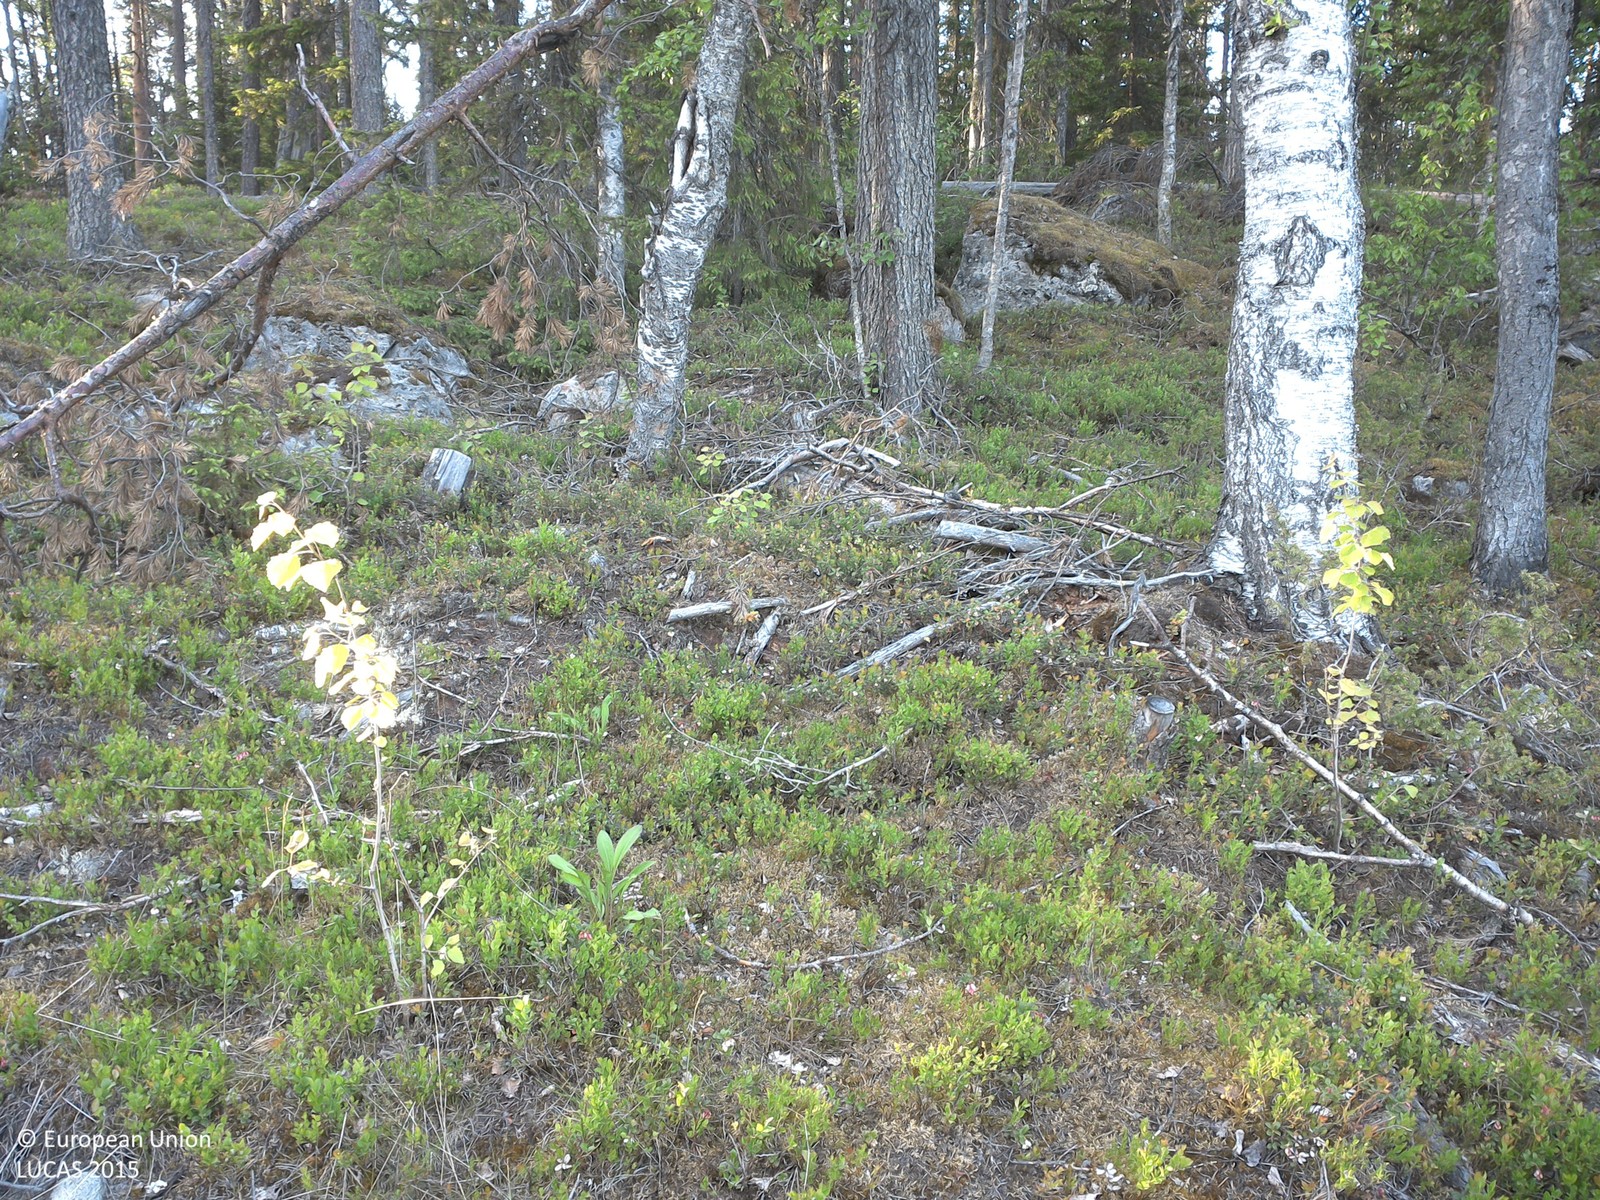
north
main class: Shrubland
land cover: Shrubland with sparse tree cover
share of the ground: 50 - 75 %
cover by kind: shrubs 50 %, unconsolidated bare surface 30 %, herbaceous plants 15 %, broadleaved forest trees 5 %
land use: Forestry
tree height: < 5 m
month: June
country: SE
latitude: 66.7515
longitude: 22.9367
